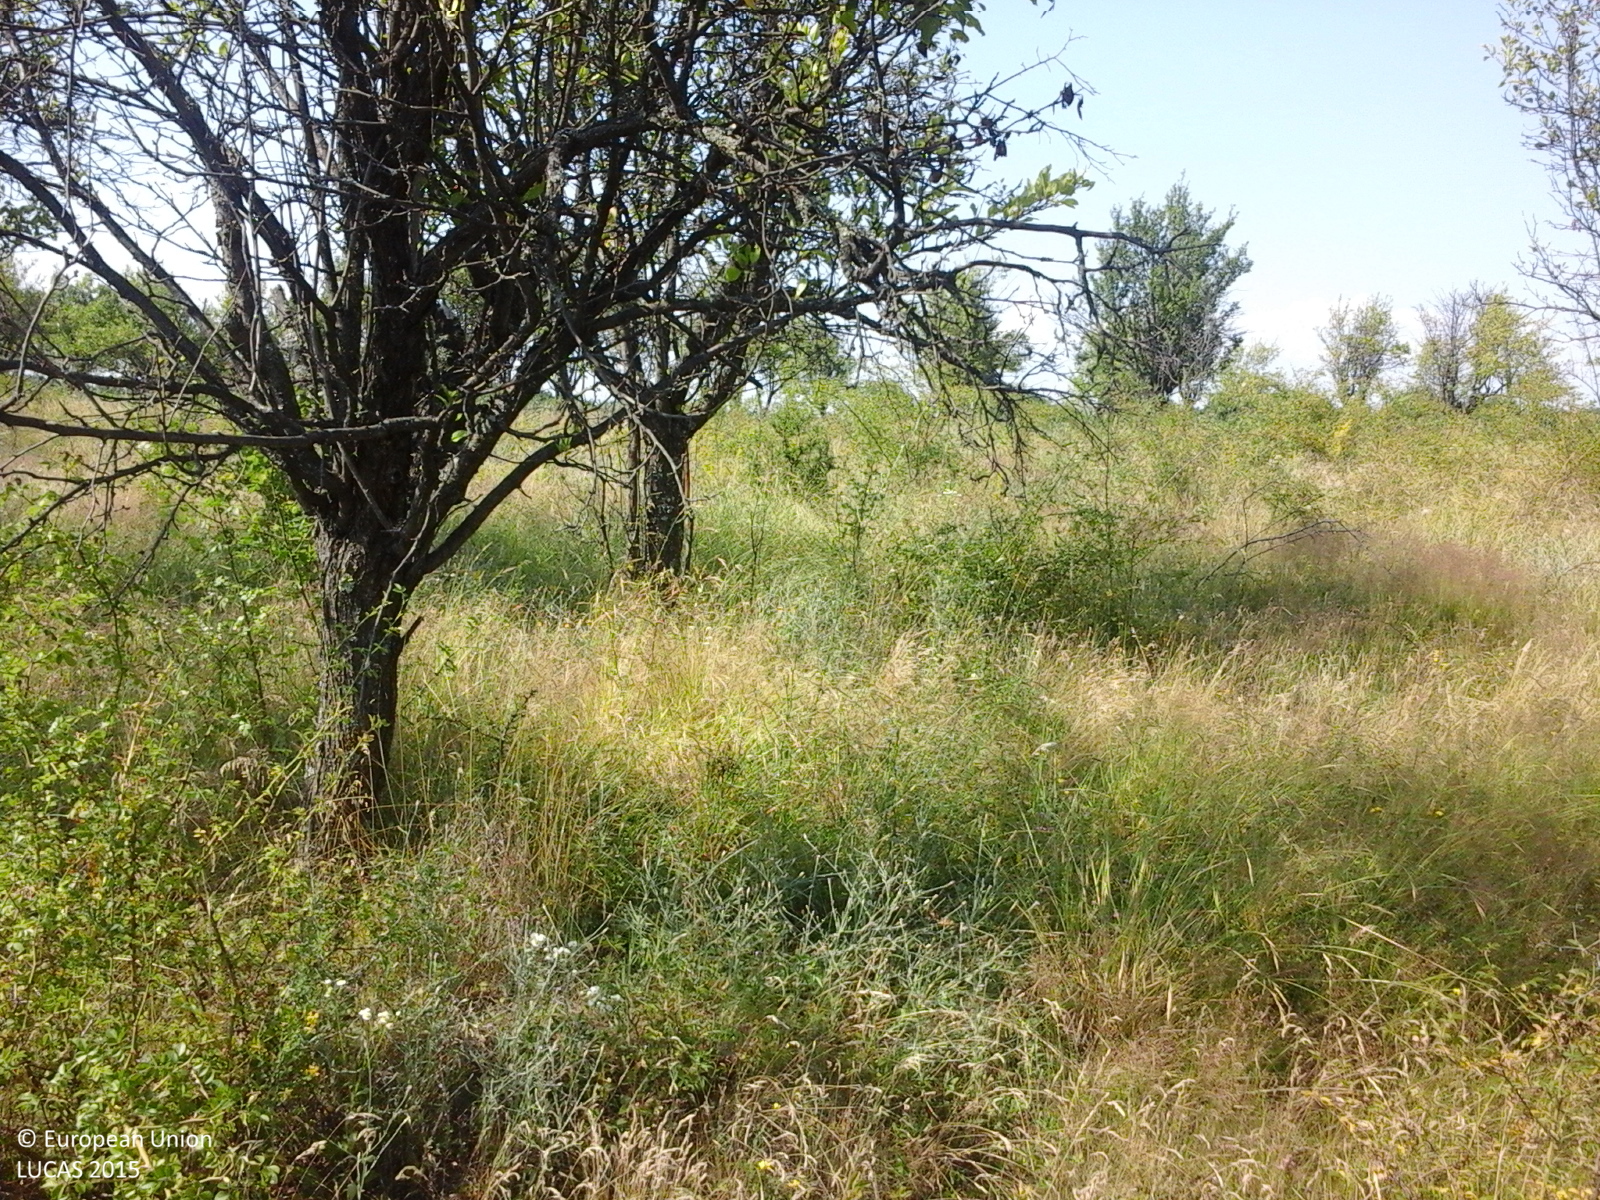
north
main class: Cropland
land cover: Apple fruit
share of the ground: > 75 %
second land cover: Grassland without tree/shrub cover
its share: > 75 %
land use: Agriculture (excluding fallow land and kitchen gardens)
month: July
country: RO
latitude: 44.7446
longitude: 24.6897
